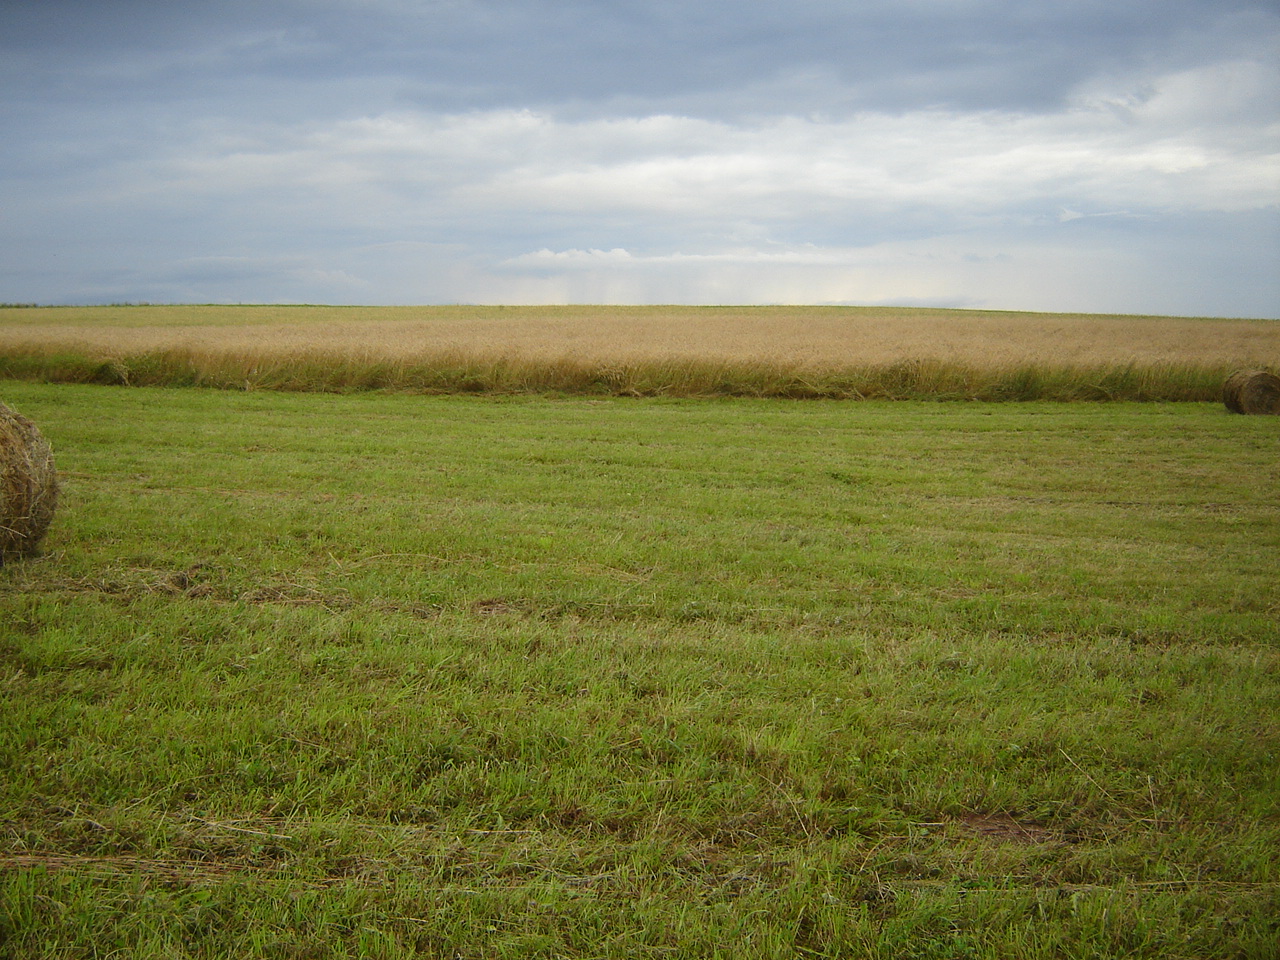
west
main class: Grassland
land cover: Grassland without tree/shrub cover
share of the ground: > 75 %
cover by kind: herbaceous plants 100 %
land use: Agriculture (excluding fallow land and kitchen gardens)
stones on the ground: < 10 %
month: July
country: LT
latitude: 55.4218
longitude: 25.0435
